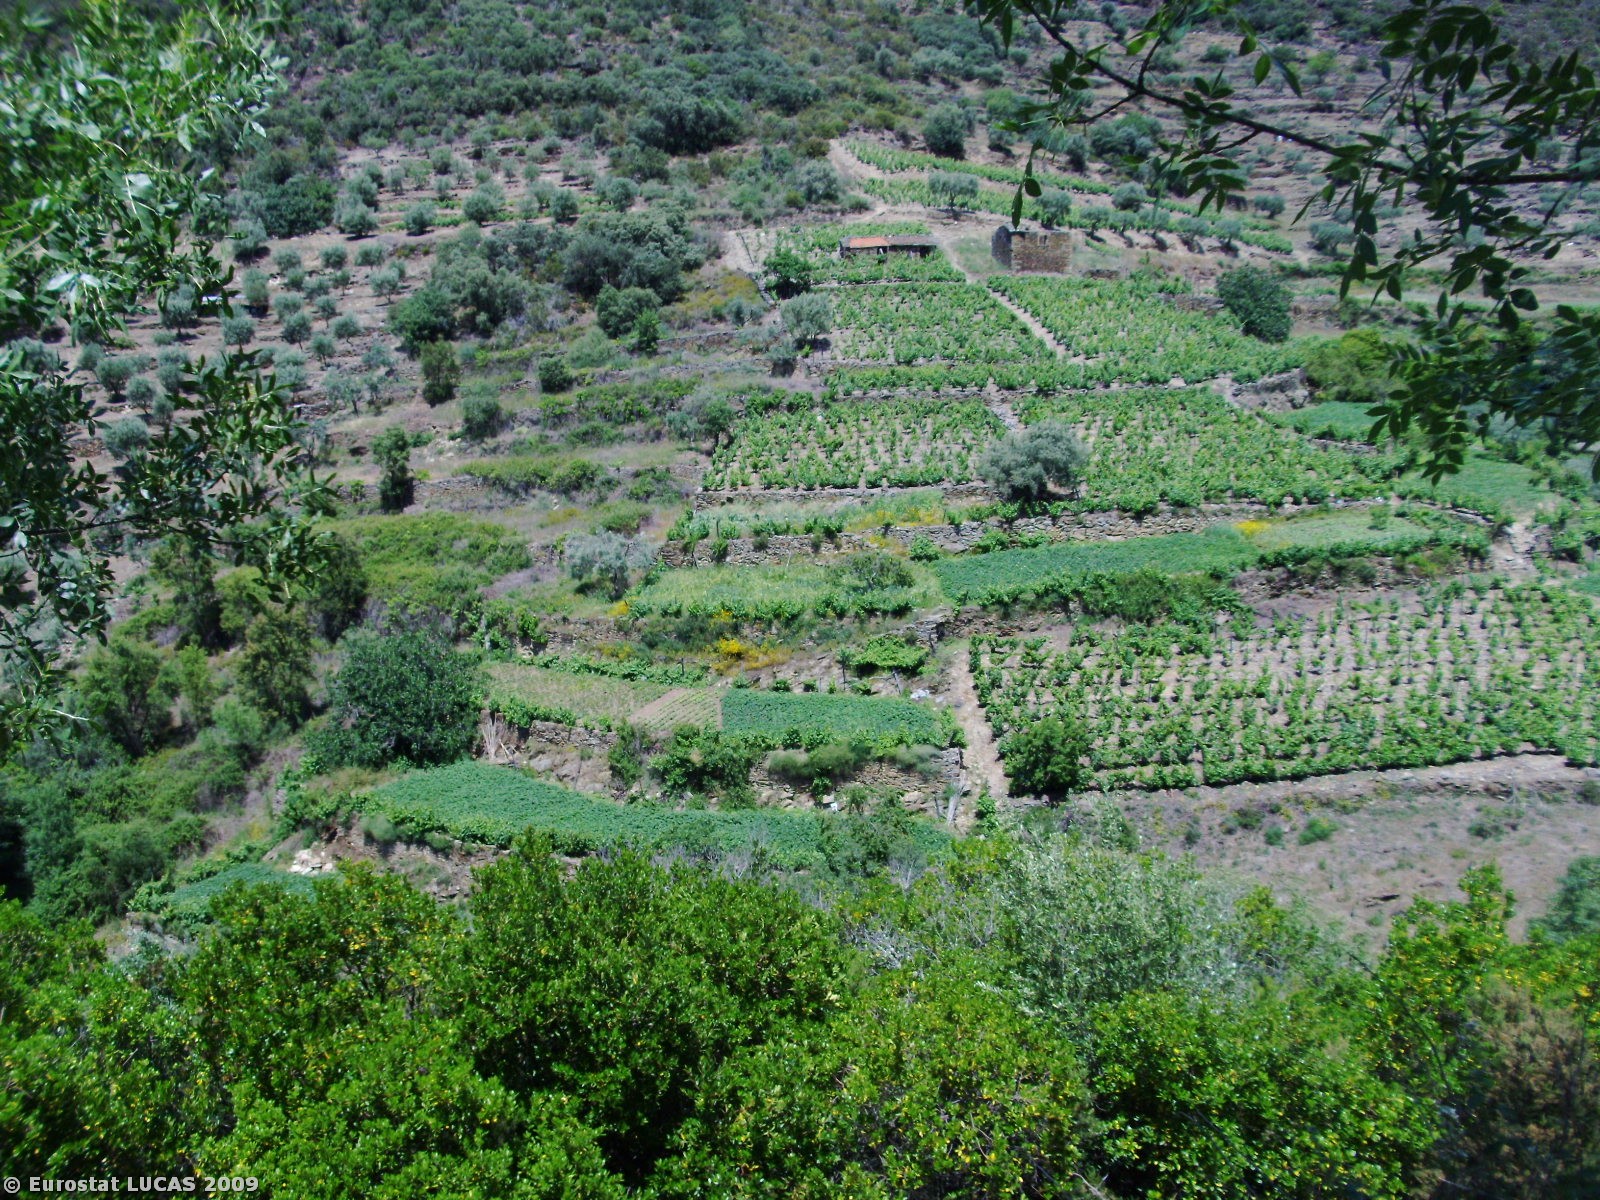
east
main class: Cropland
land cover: Potatoes
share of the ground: 50 - 75 %
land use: Agriculture (excluding fallow land and kitchen gardens)
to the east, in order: Potatoes; Dry stone walls; Dry pulses; Dry stone walls; Potatoes; Dry stone walls; Vineyards; Tracks; Dry stone walls; Potatoes; Shrubland without tree cover; Rivers and streams; Shrubland with sparse tree cover; Broadleaved woodland; Rivers and streams; Potatoes
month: May
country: PT
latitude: 41.1311
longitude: -7.6235
